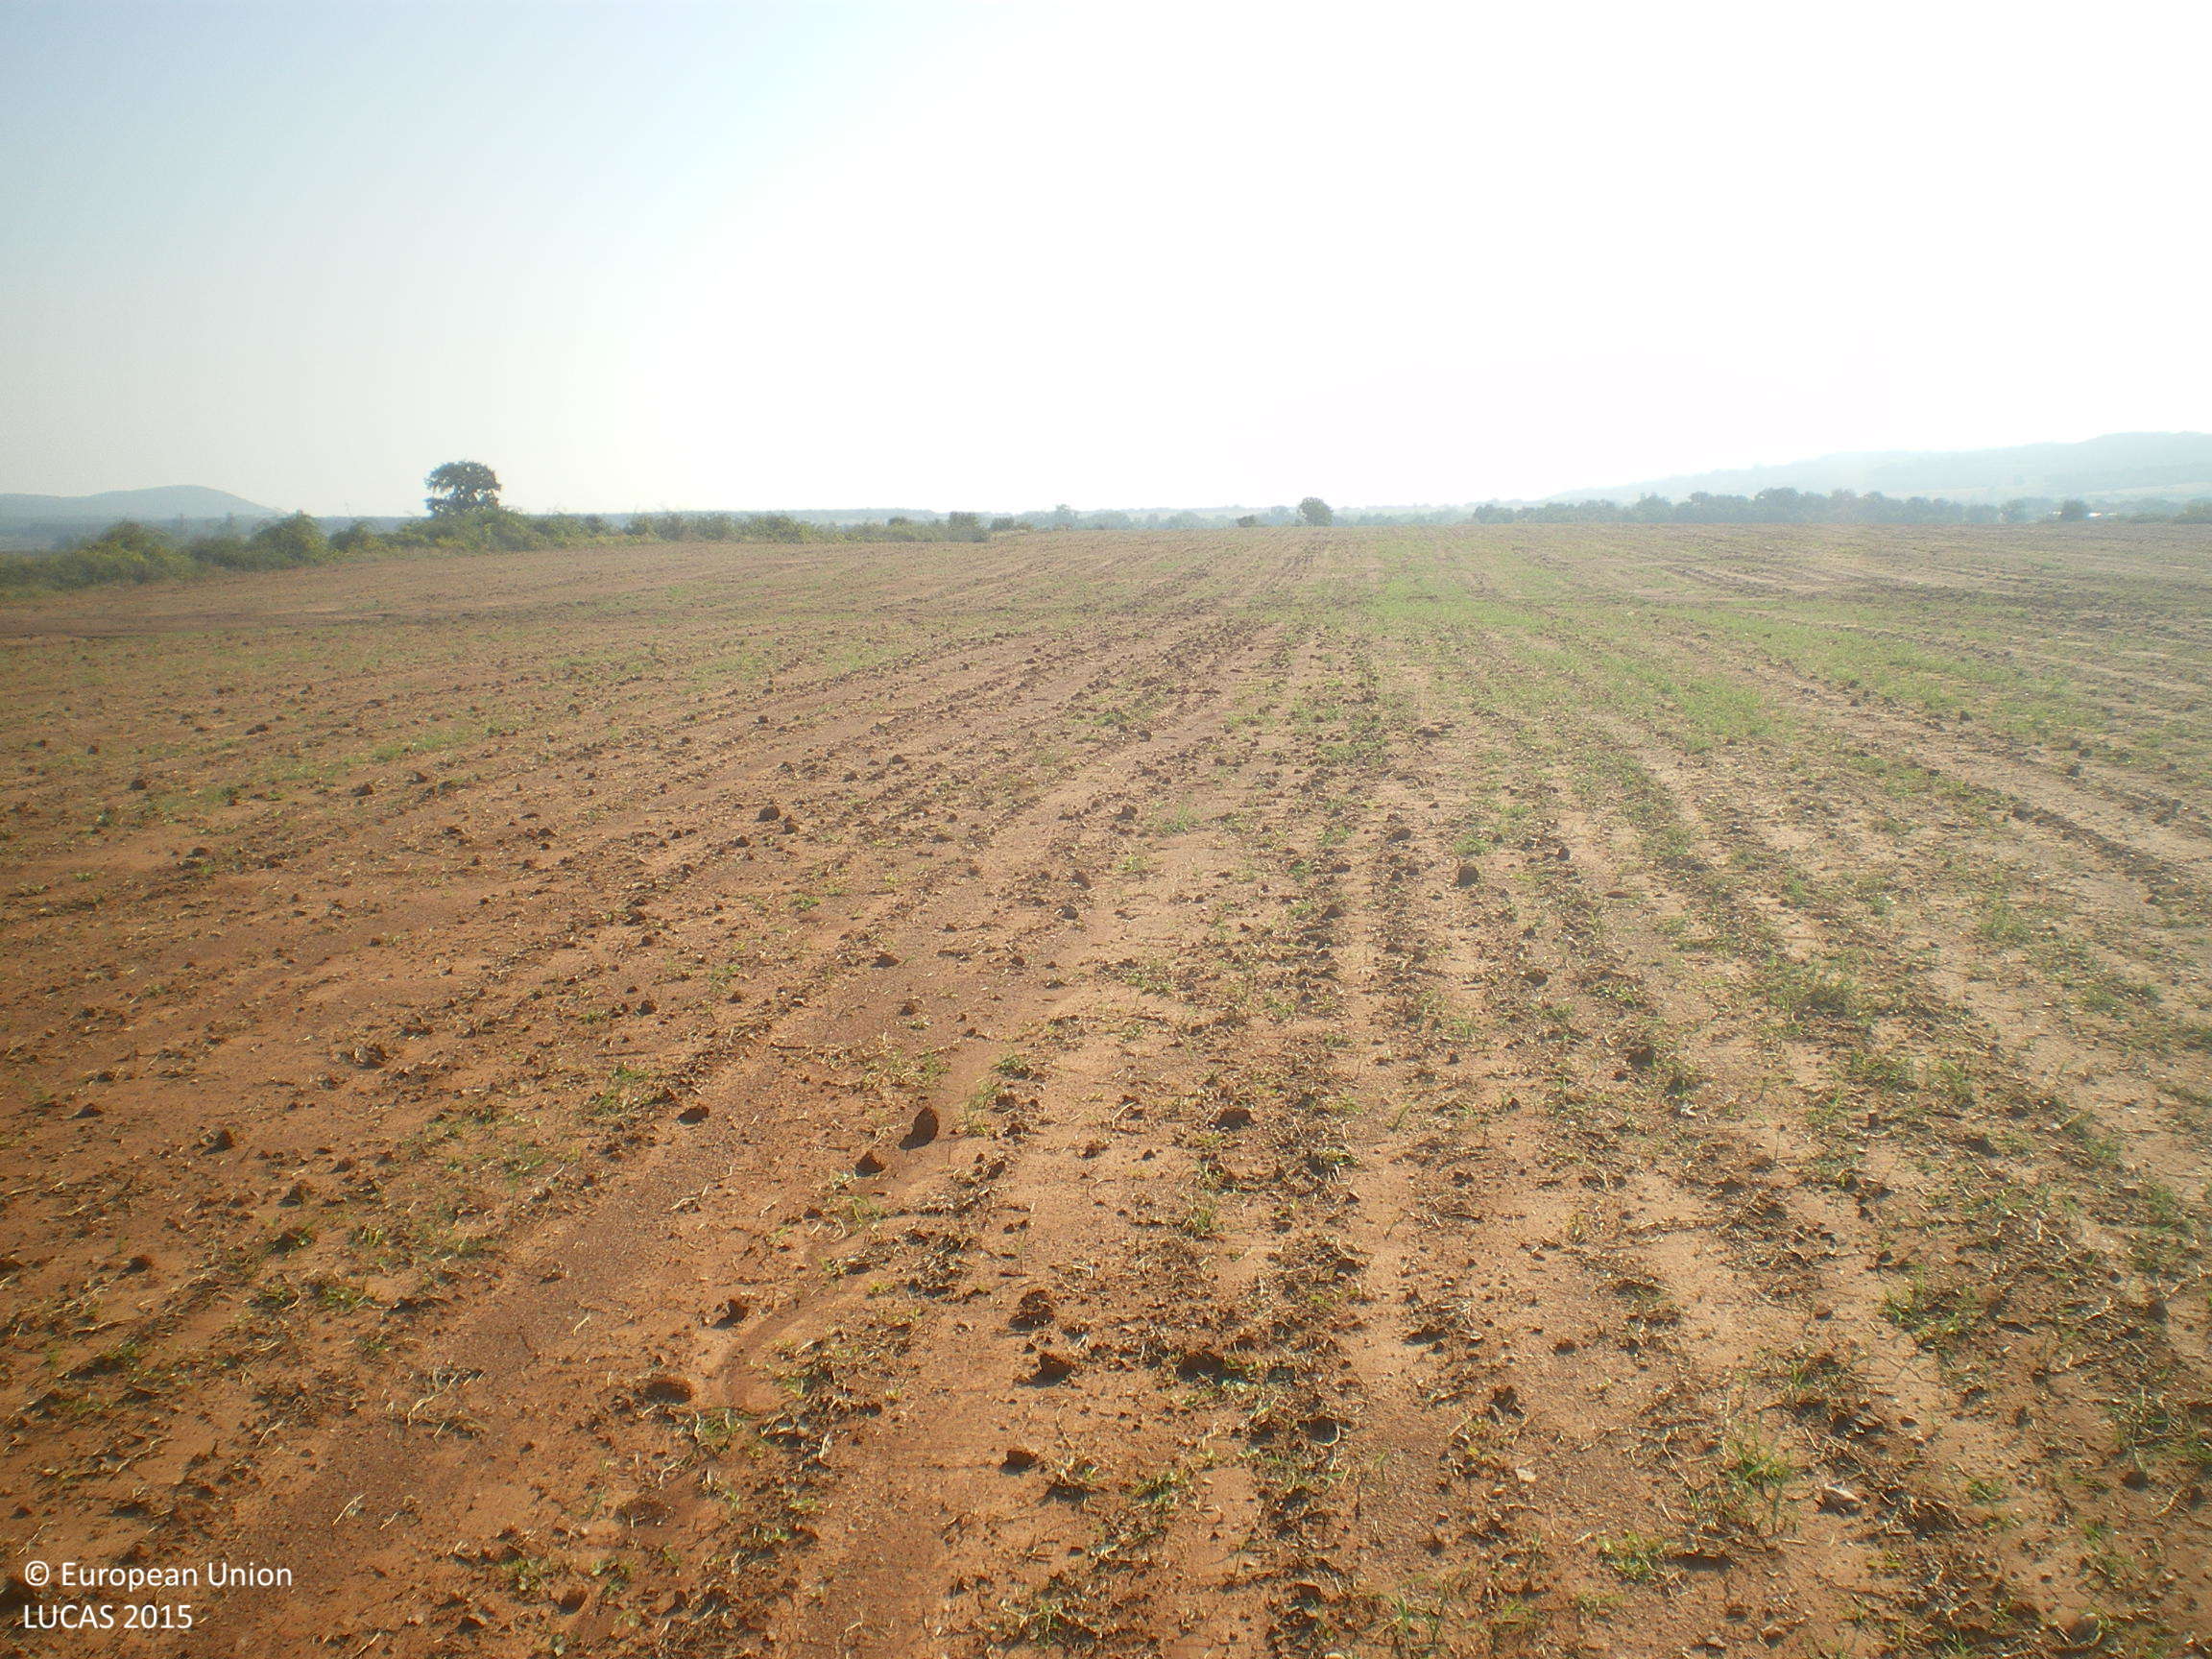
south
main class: Cropland
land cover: Common wheat
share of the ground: < 10 %
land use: Agriculture (excluding fallow land and kitchen gardens)
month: September
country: BG
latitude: 41.7762
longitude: 25.8895
